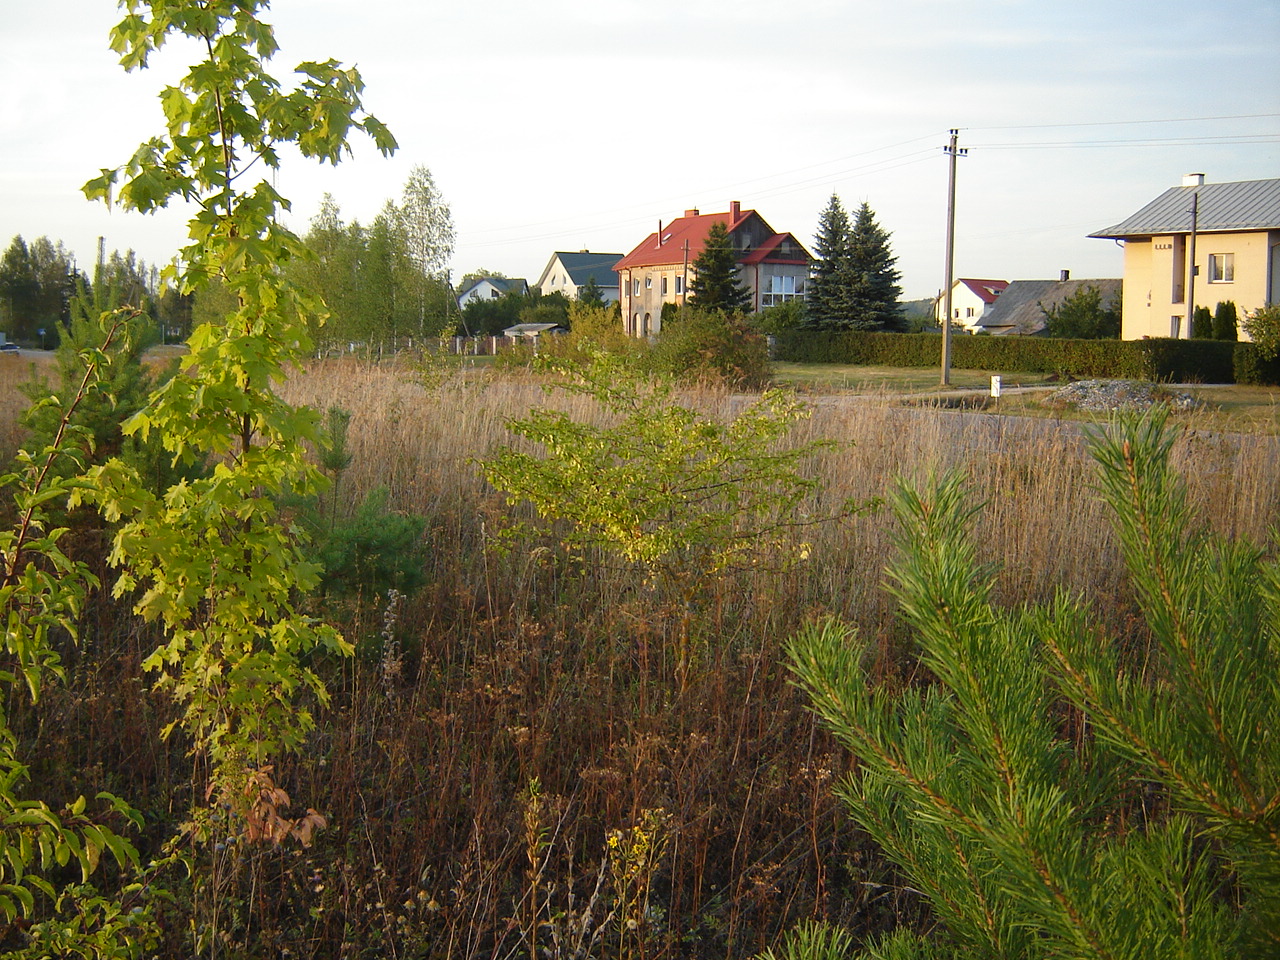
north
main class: Woodland
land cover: Pine dominated mixed woodland
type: hemiboreal forest and nemoral coniferous forest and mixed broadleaved-coniferous forest
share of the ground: 25 - 50 %
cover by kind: herbaceous plants 60 %, coniferous forest trees 25 %, broadleaved forest trees 15 %
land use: Forestry
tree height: < 5 m
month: August
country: LT
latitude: 54.5774
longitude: 25.2035
